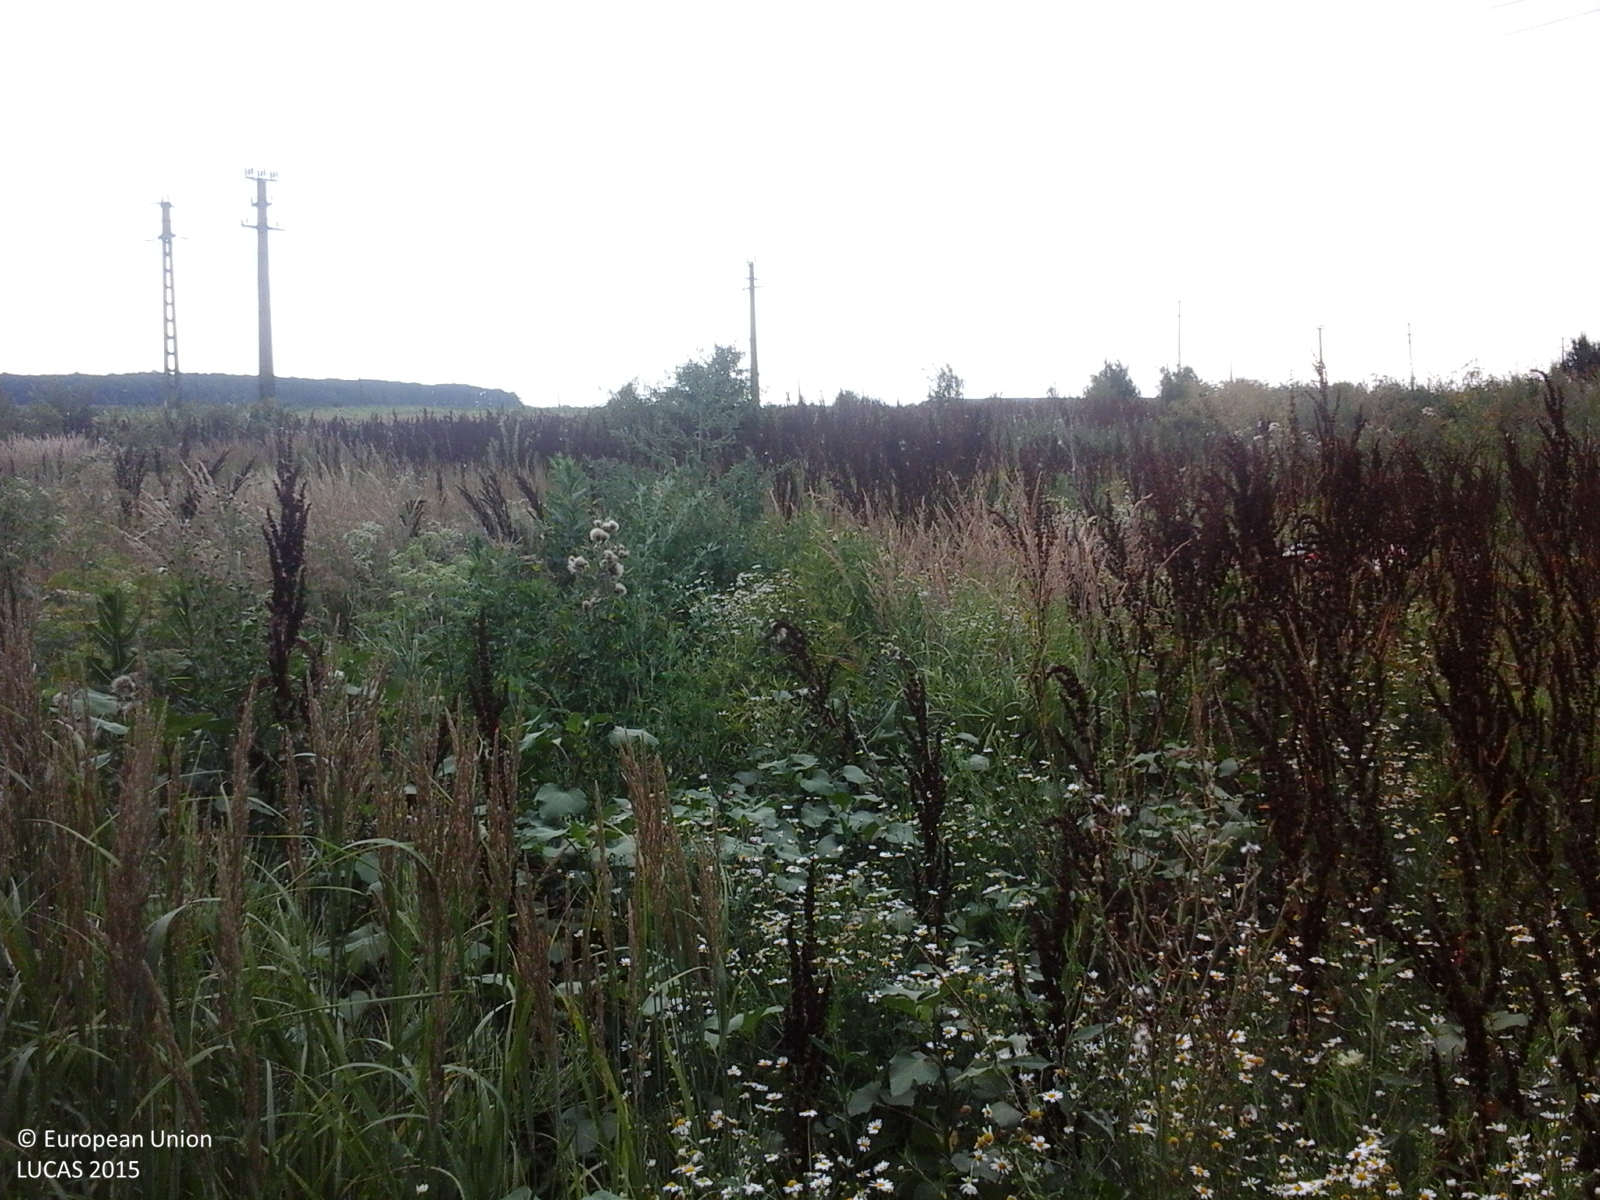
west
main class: Grassland
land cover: Spontaneously vegetated surfaces
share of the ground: > 75 %
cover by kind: herbaceous plants 100 %
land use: Fallow land
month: July
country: RO
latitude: 44.3156
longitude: 25.3704
